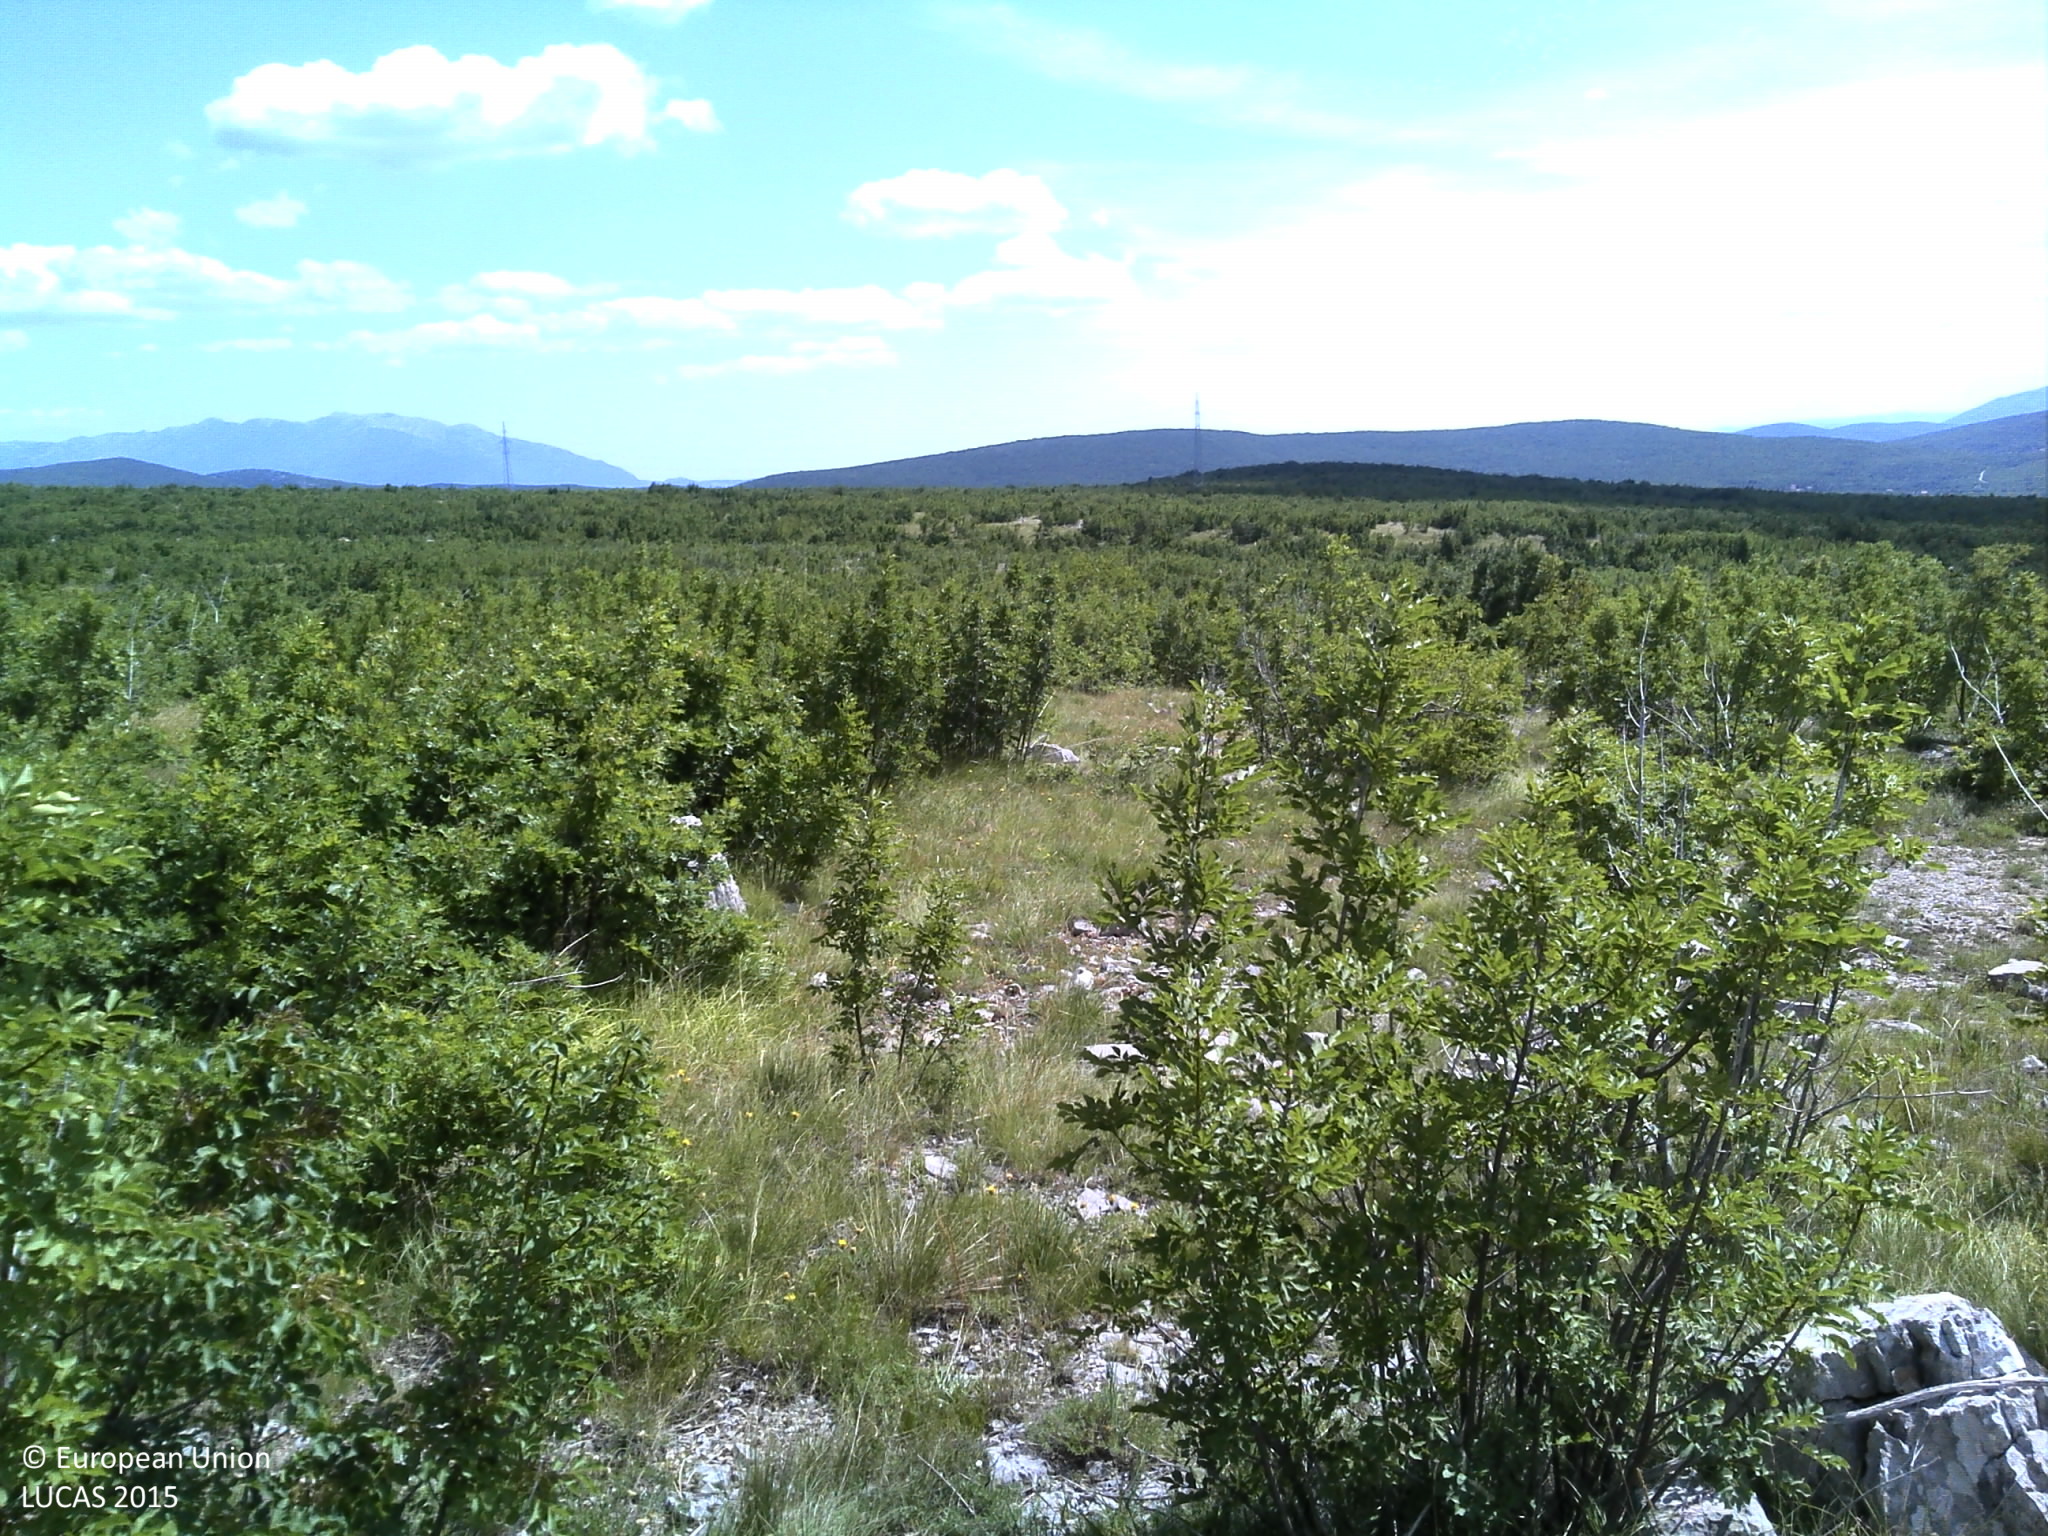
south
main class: Shrubland
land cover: Shrubland with sparse tree cover
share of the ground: > 75 %
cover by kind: shrubs 65 %, herbaceous plants 10 %, consolidated bare surface 10 %, unconsolidated bare surface 10 %, broadleaved forest trees 5 %
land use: Semi-natural and natural areas not in use
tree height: < 5 m
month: June
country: HR
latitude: 43.6127
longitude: 16.9184
